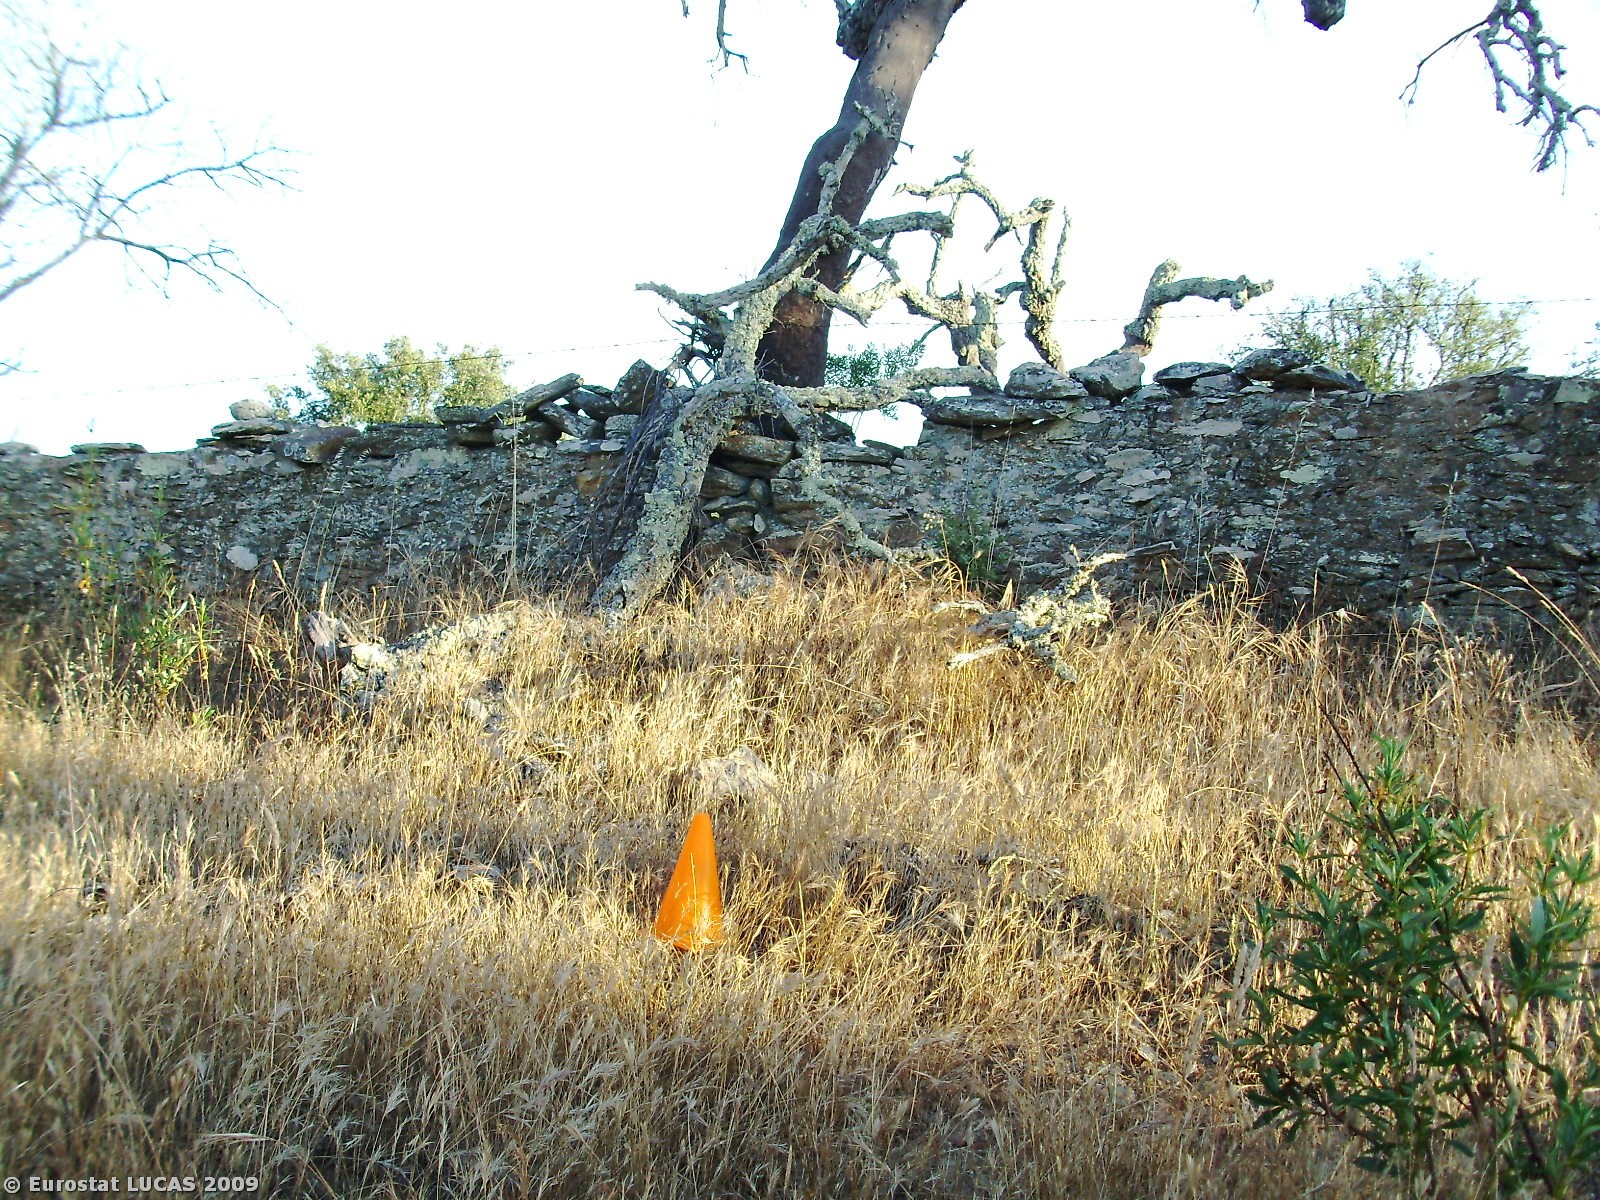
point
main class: Woodland
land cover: Broadleaved woodland
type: broadleaved evergreen forest
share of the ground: 10 - 25 %
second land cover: Spontaneously vegetated surfaces
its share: 50 - 75 %
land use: Forestry
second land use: Fallow land
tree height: > 5 m
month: April
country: PT
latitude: 39.5415
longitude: -7.5371
